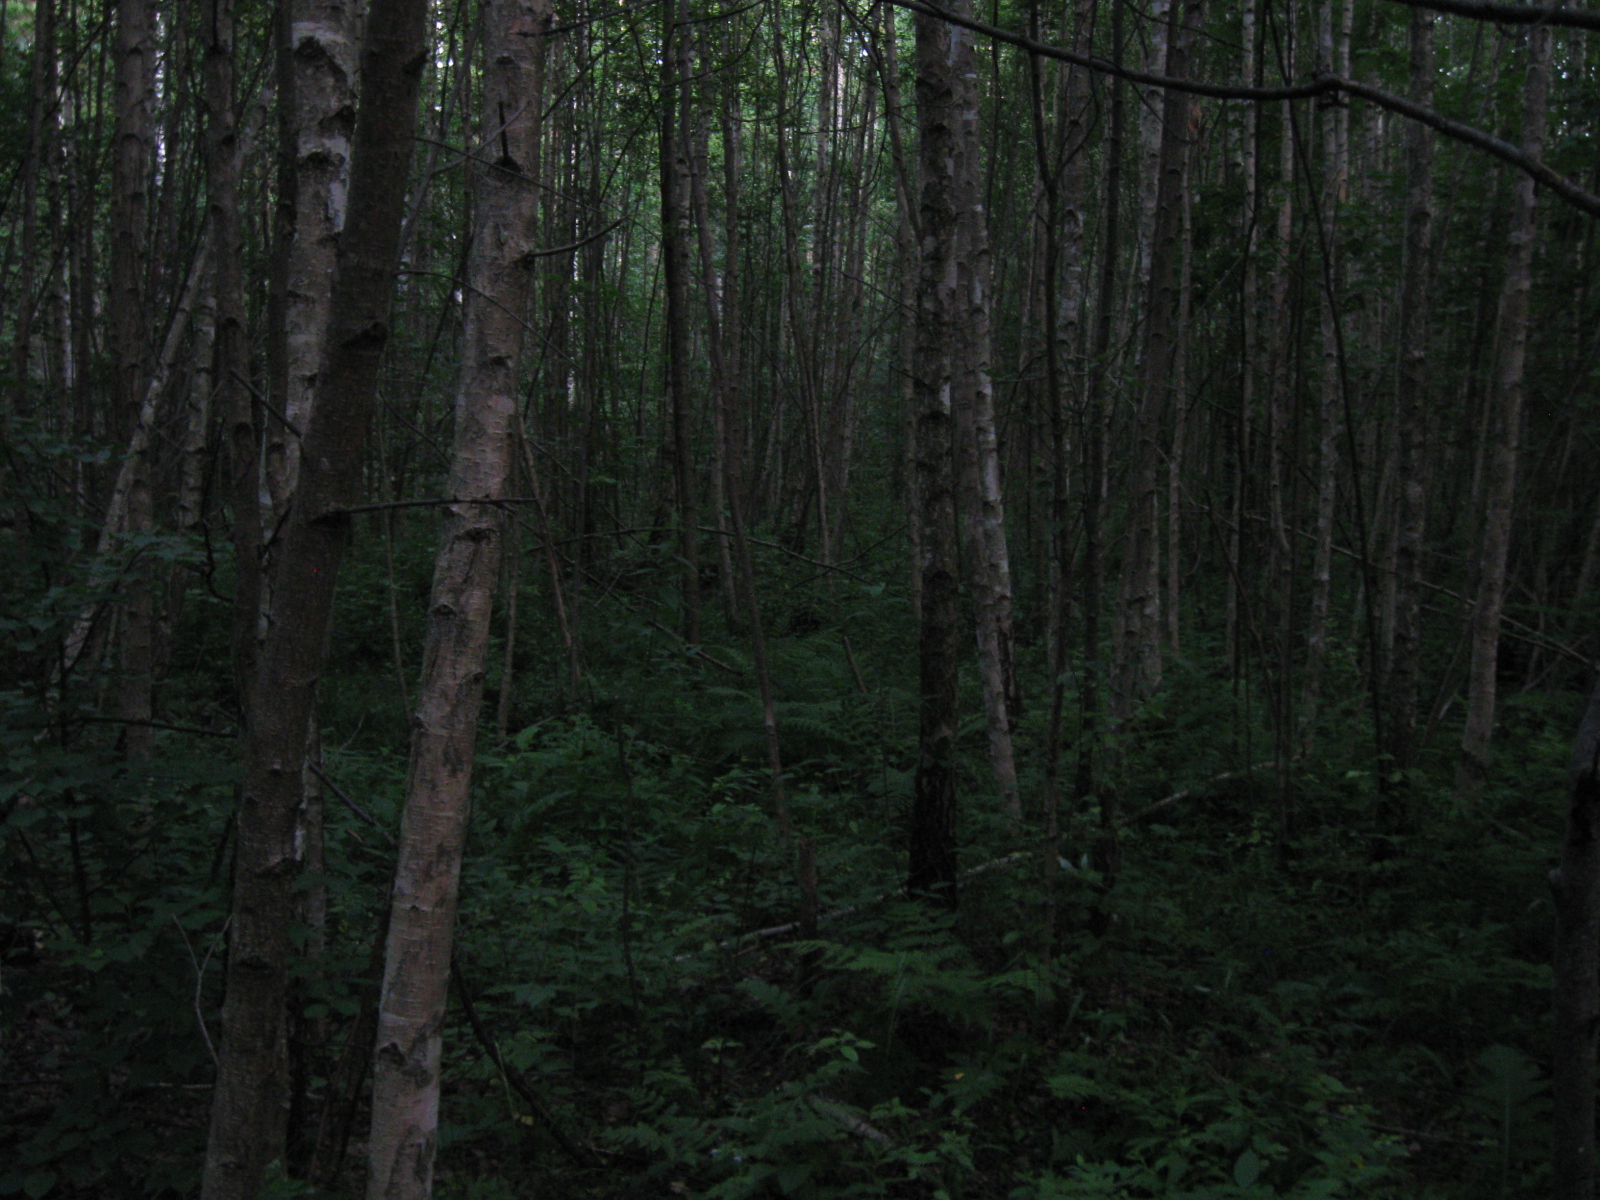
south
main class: Woodland
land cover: Broadleaved woodland
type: non-riverine alder, birch or aspen forest
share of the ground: > 75 %
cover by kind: broadleaved forest trees 85 %, herbaceous plants 10 %, shrubs 5 %
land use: Forestry
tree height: > 5 m
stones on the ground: < 10 %
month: July
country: LT
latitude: 55.0866
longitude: 23.6668
